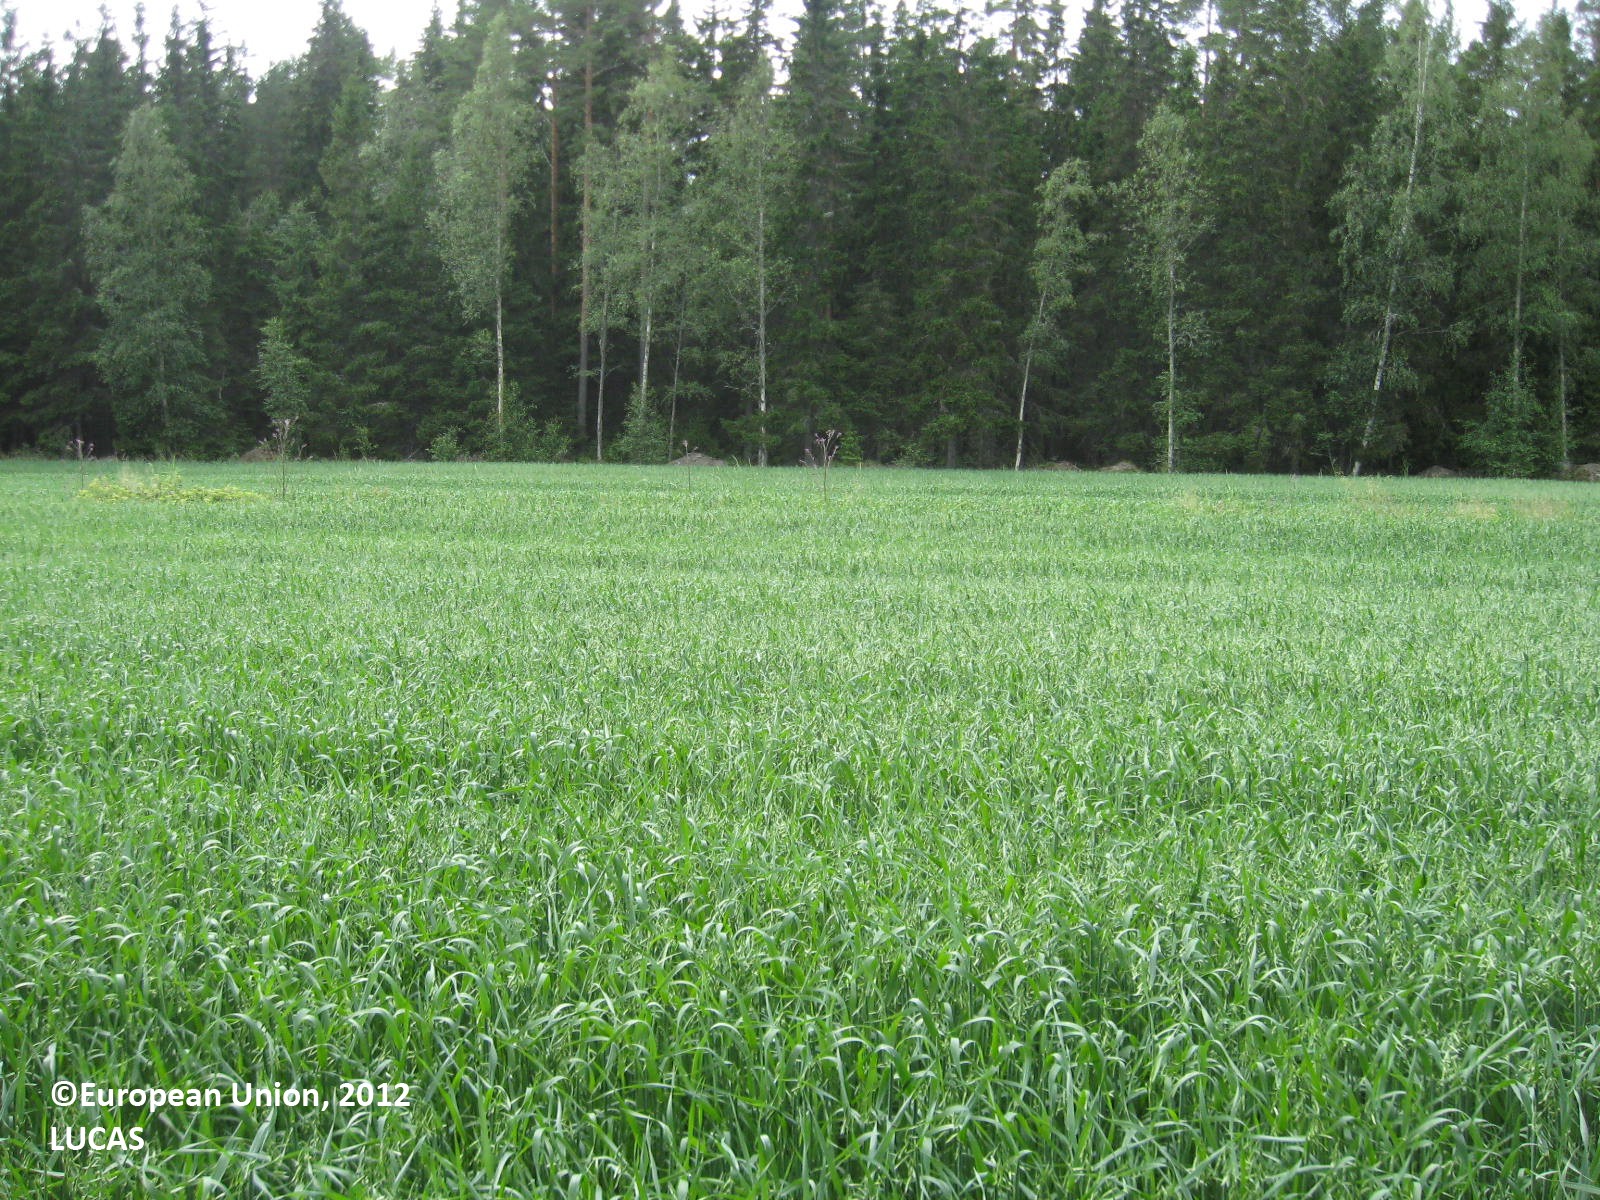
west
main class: Cropland
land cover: Oats
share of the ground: > 75 %
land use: Agriculture (excluding fallow land and kitchen gardens)
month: July
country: FI
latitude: 62.5770
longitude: 21.1917
